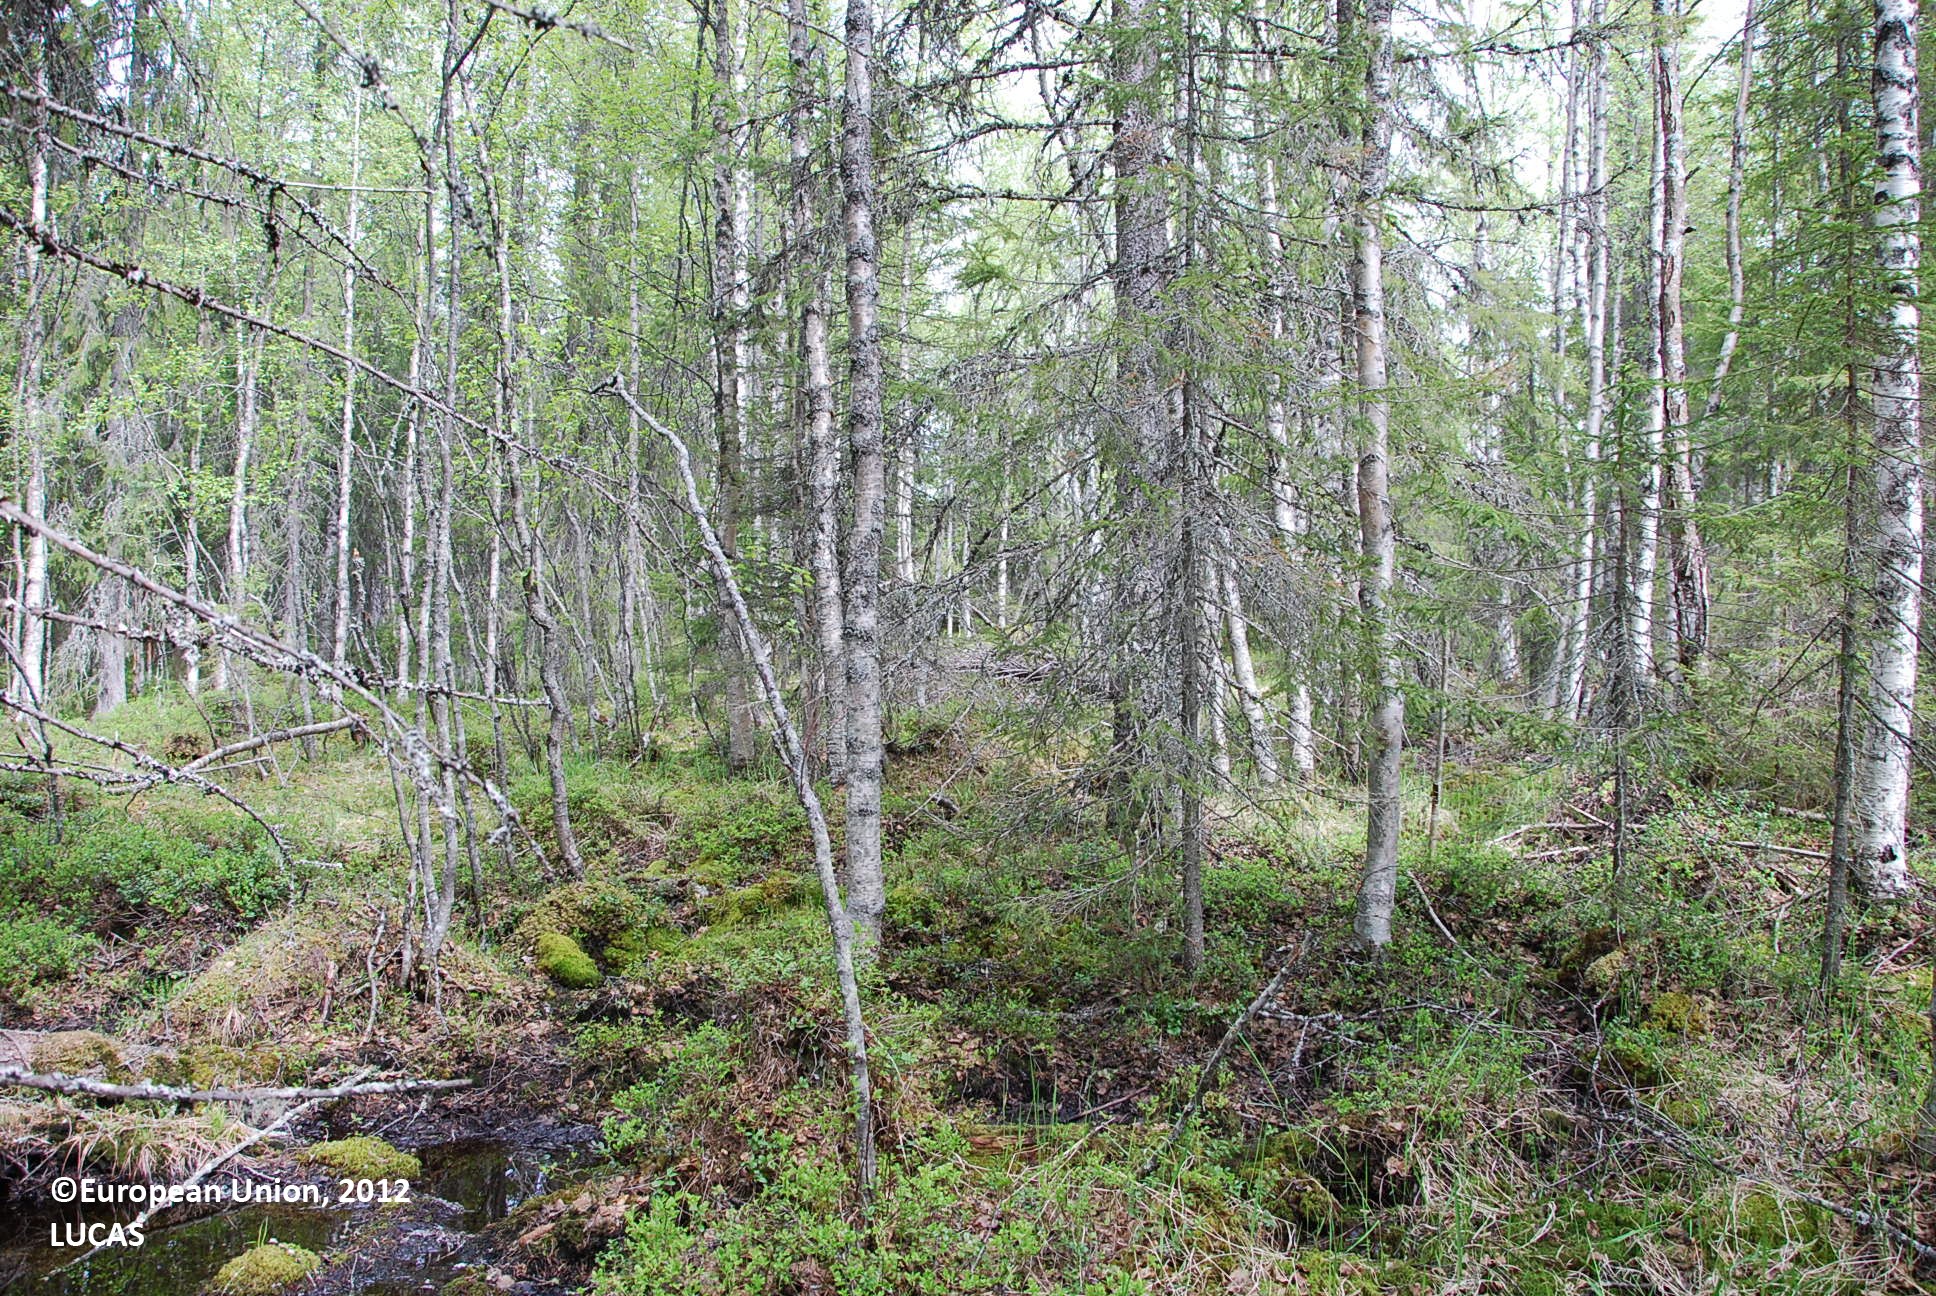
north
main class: Woodland
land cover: Spruce dominated mixed woodland
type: boreal forest
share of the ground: > 75 %
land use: Forestry
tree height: > 5 m
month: June
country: FI
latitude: 66.2062
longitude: 27.6949
